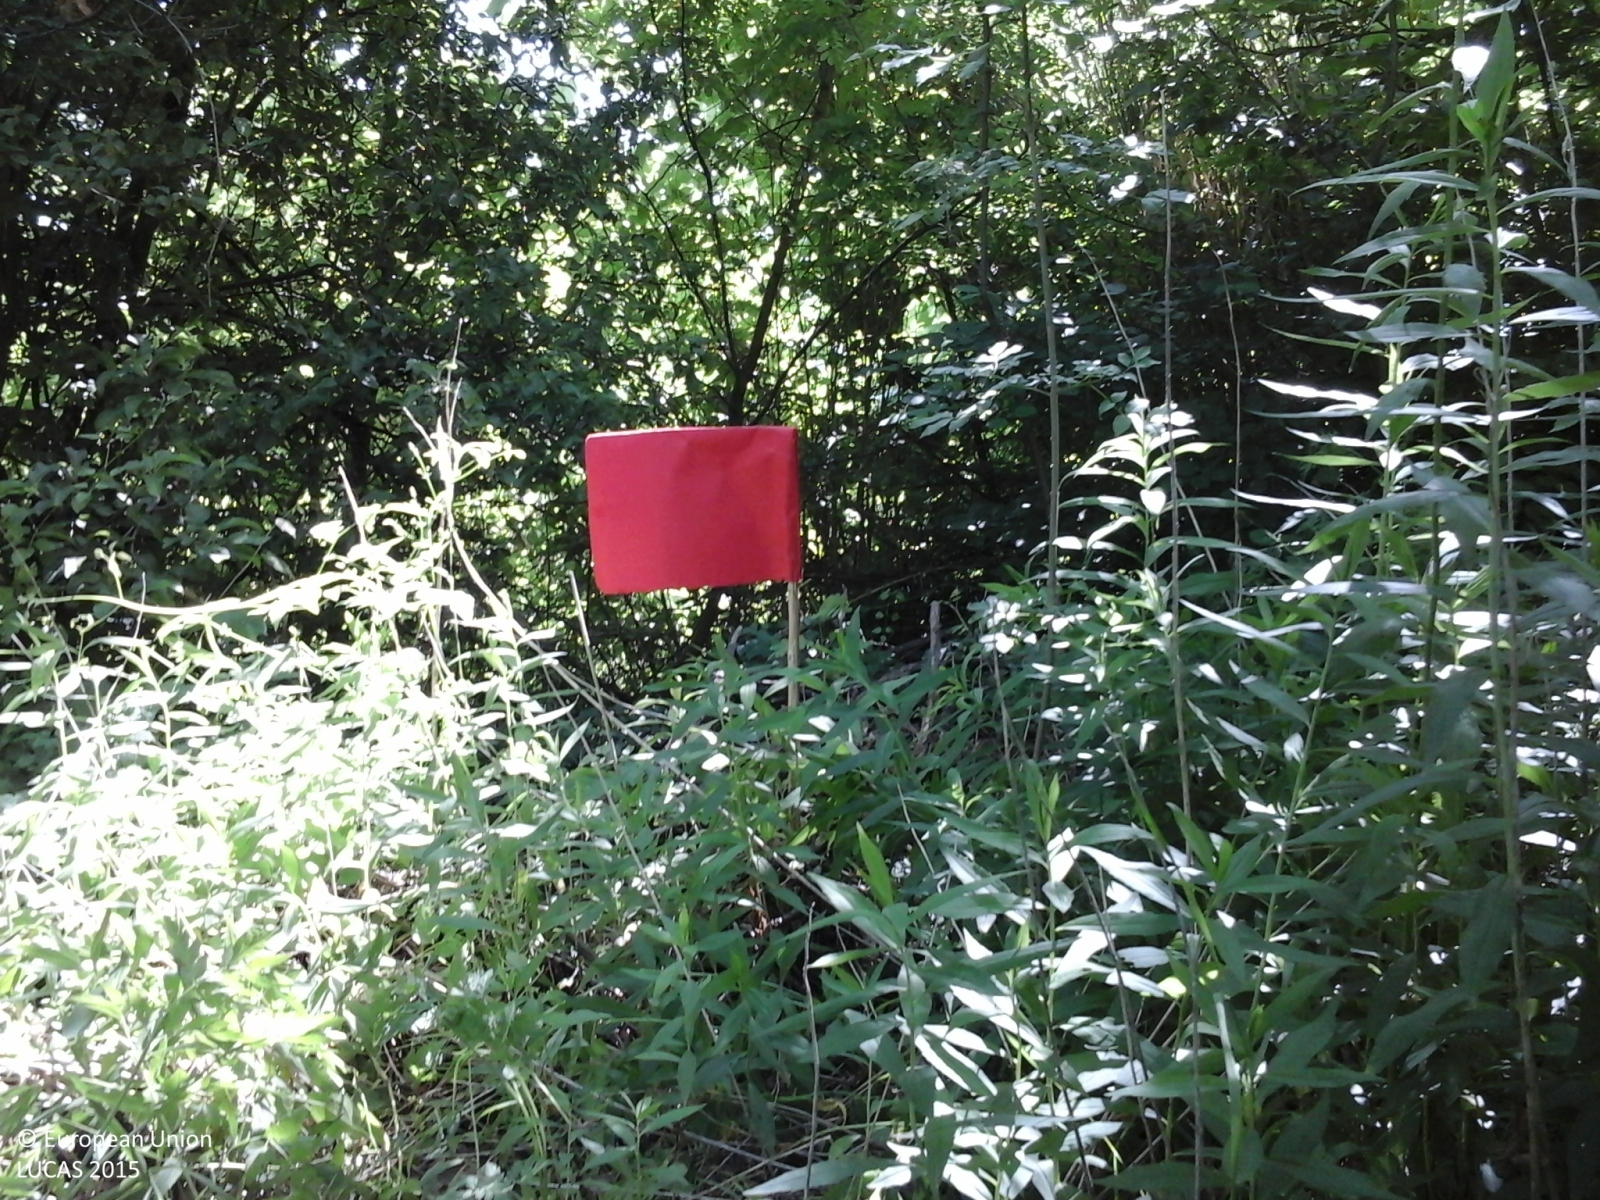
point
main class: Woodland
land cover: Broadleaved woodland
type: mesophytic deciduous forest
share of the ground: > 75 %
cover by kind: broadleaved forest trees 85 %, shrubs 10 %, herbaceous plants 5 %
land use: Forestry
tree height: > 5 m
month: June
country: IT
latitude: 44.6437
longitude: 8.3266
